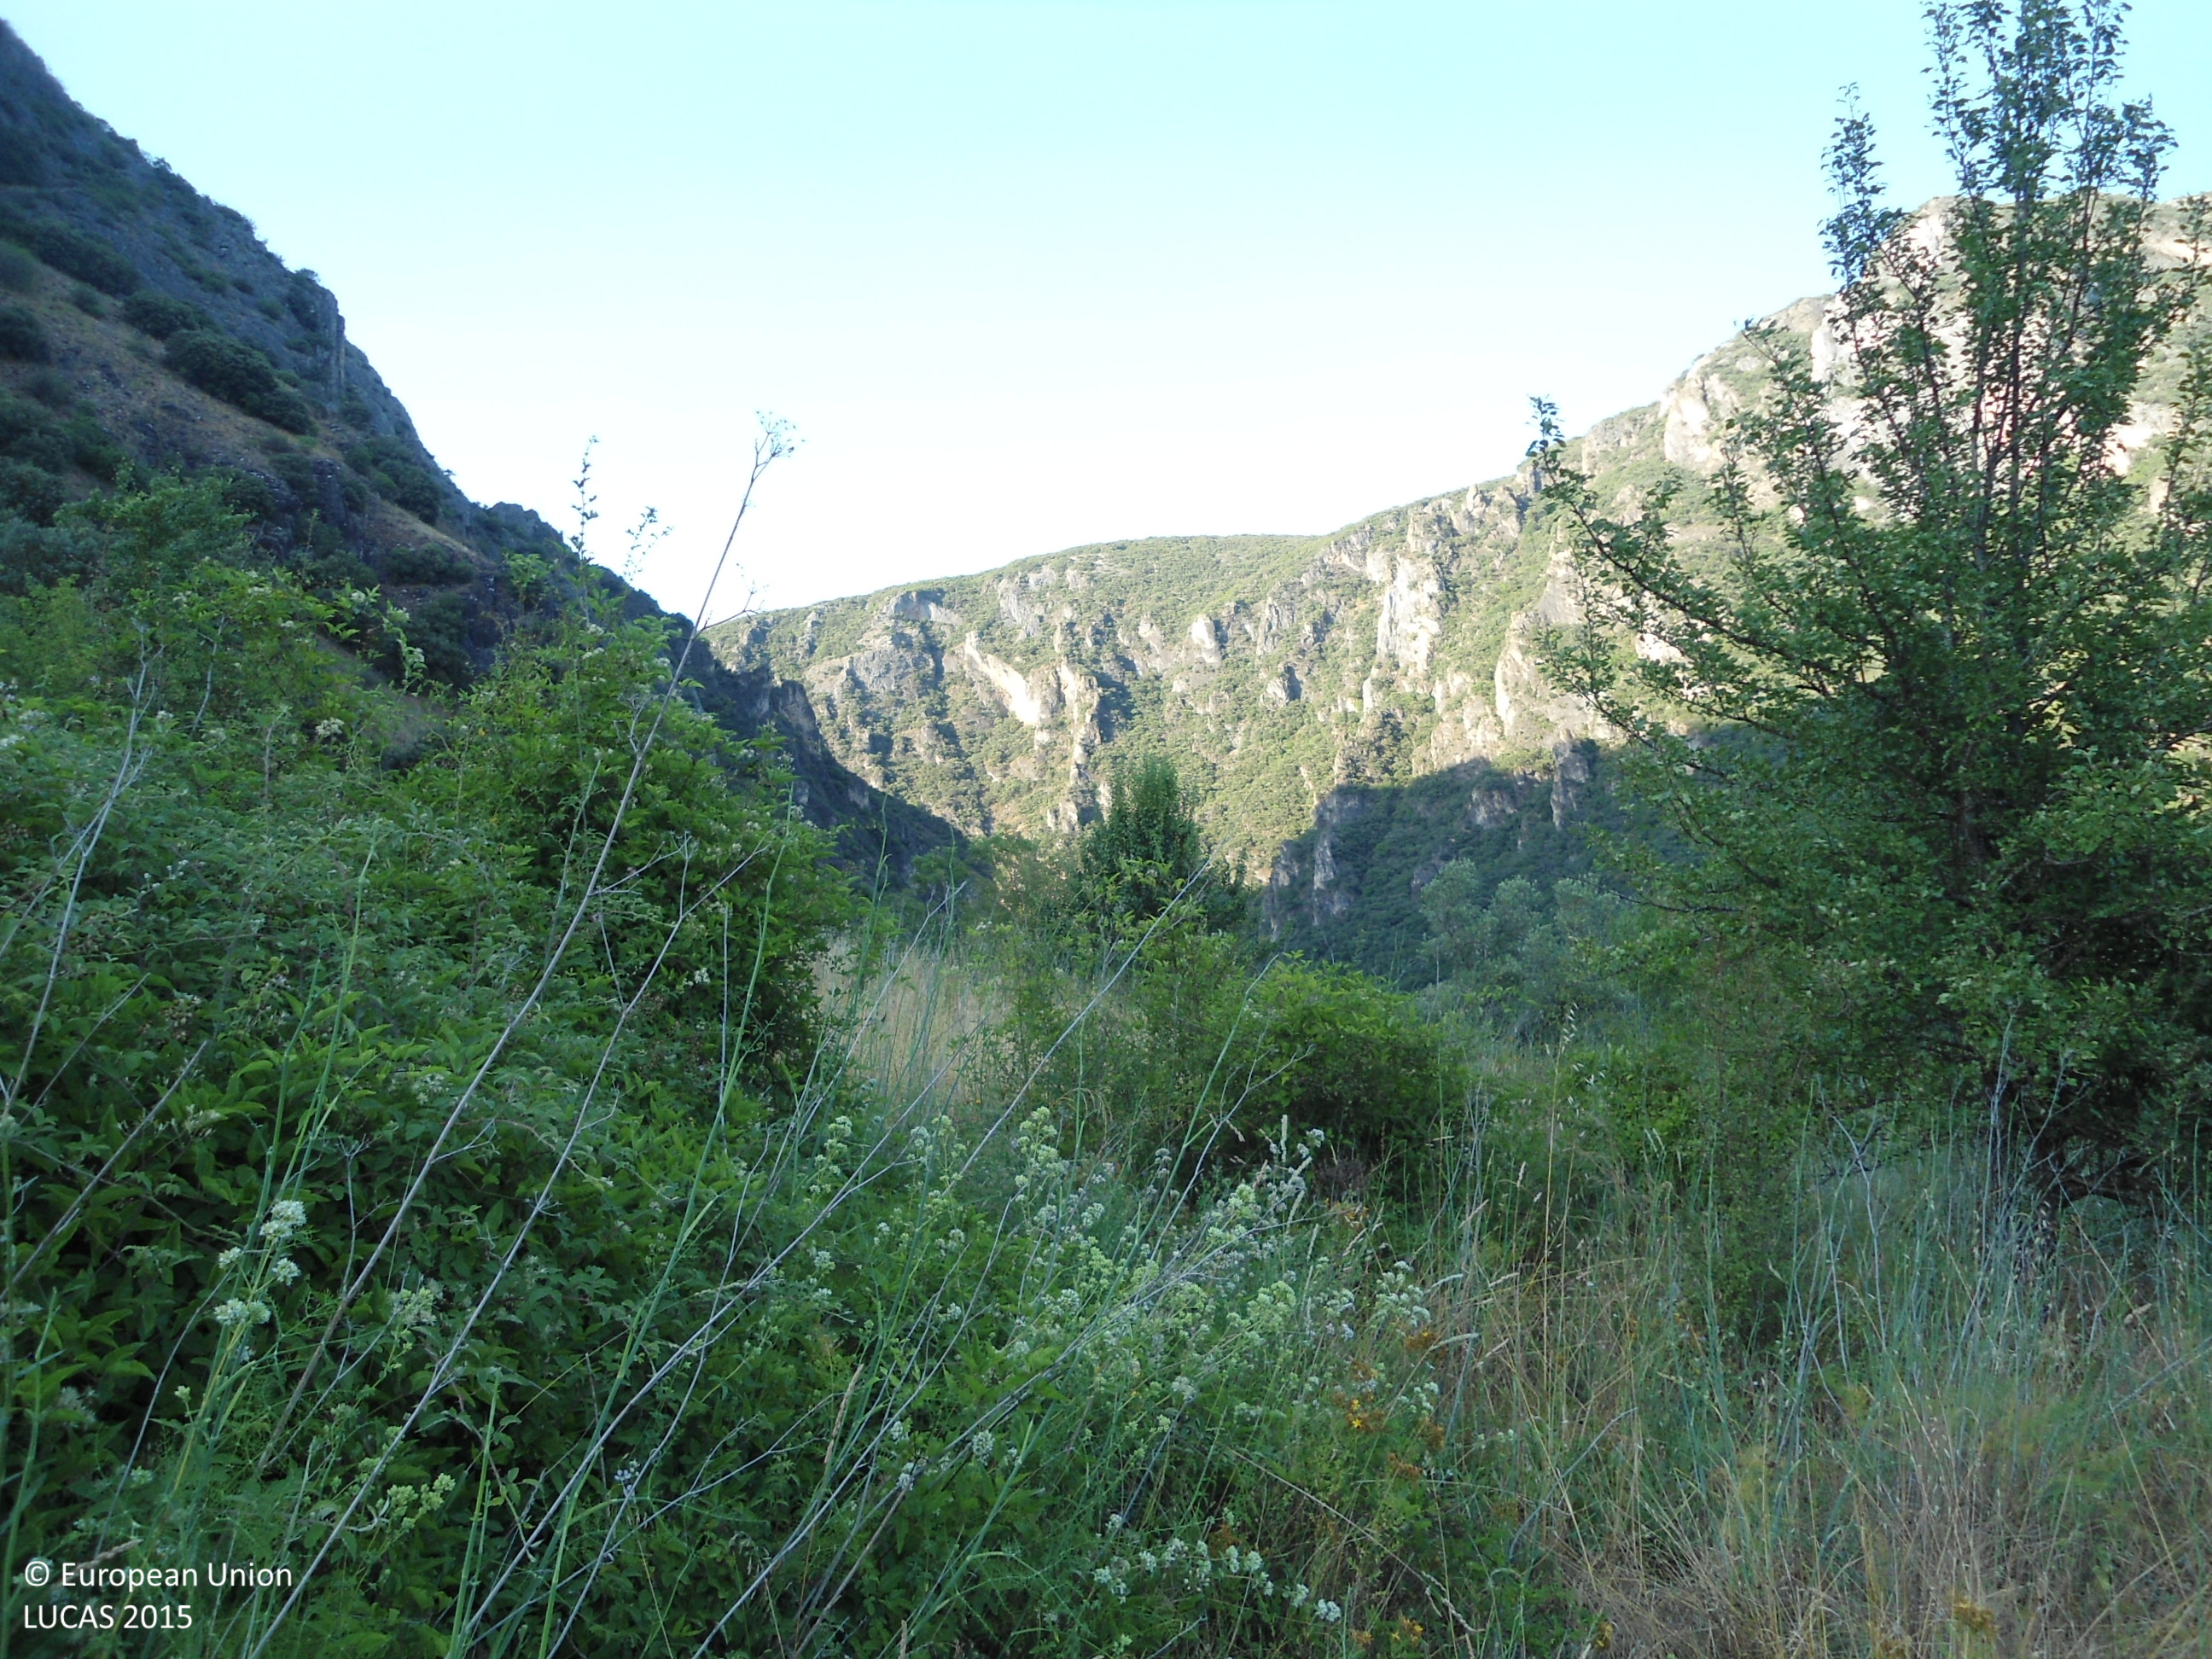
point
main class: Woodland
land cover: Broadleaved woodland
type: thermophilous deciduous forest
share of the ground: > 75 %
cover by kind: broadleaved forest trees 85 %, shrubs 15 %
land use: Forestry
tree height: < 5 m
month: June
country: ES
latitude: 42.4858
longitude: -6.8281
